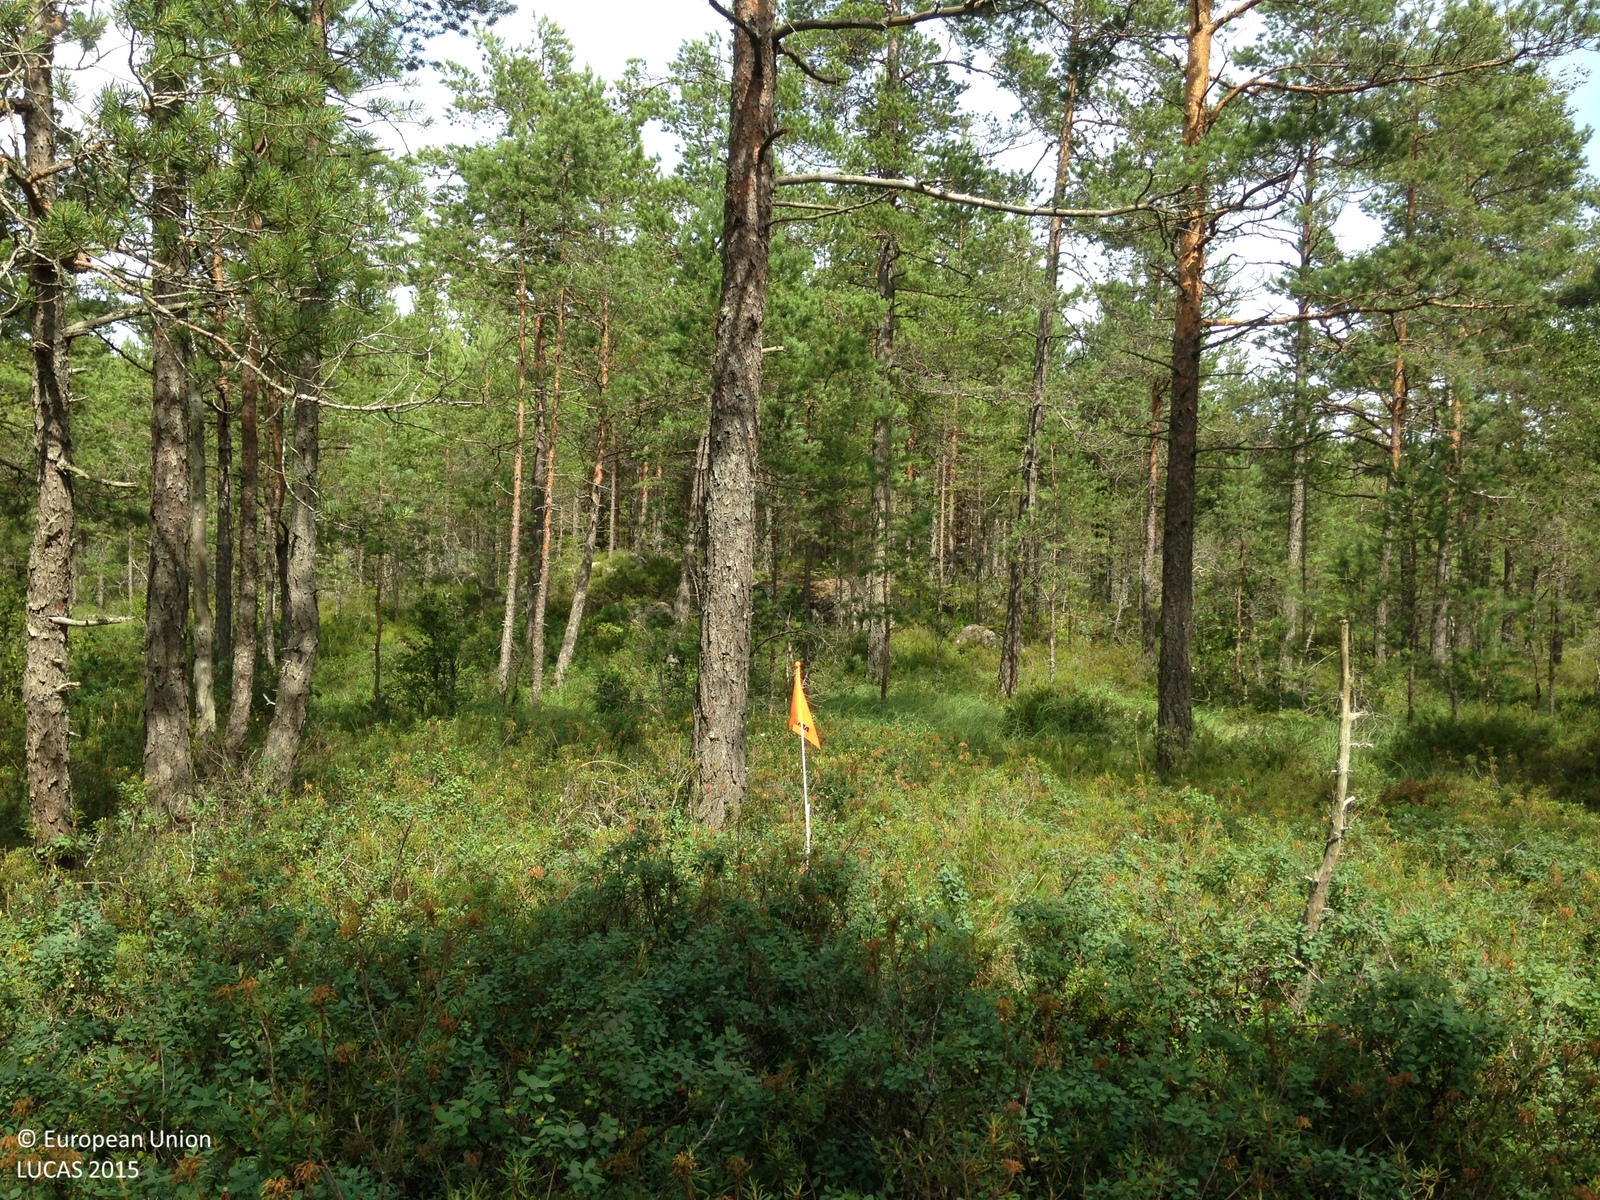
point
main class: Woodland
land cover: Pine dominated coniferous woodland
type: boreal forest
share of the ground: 10 - 25 %
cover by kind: shrubs 50 %, coniferous forest trees 20 %, lichens and mosses 20 %, herbaceous plants 10 %
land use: Forestry
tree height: > 5 m
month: July
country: SE
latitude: 58.9744
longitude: 14.4627
